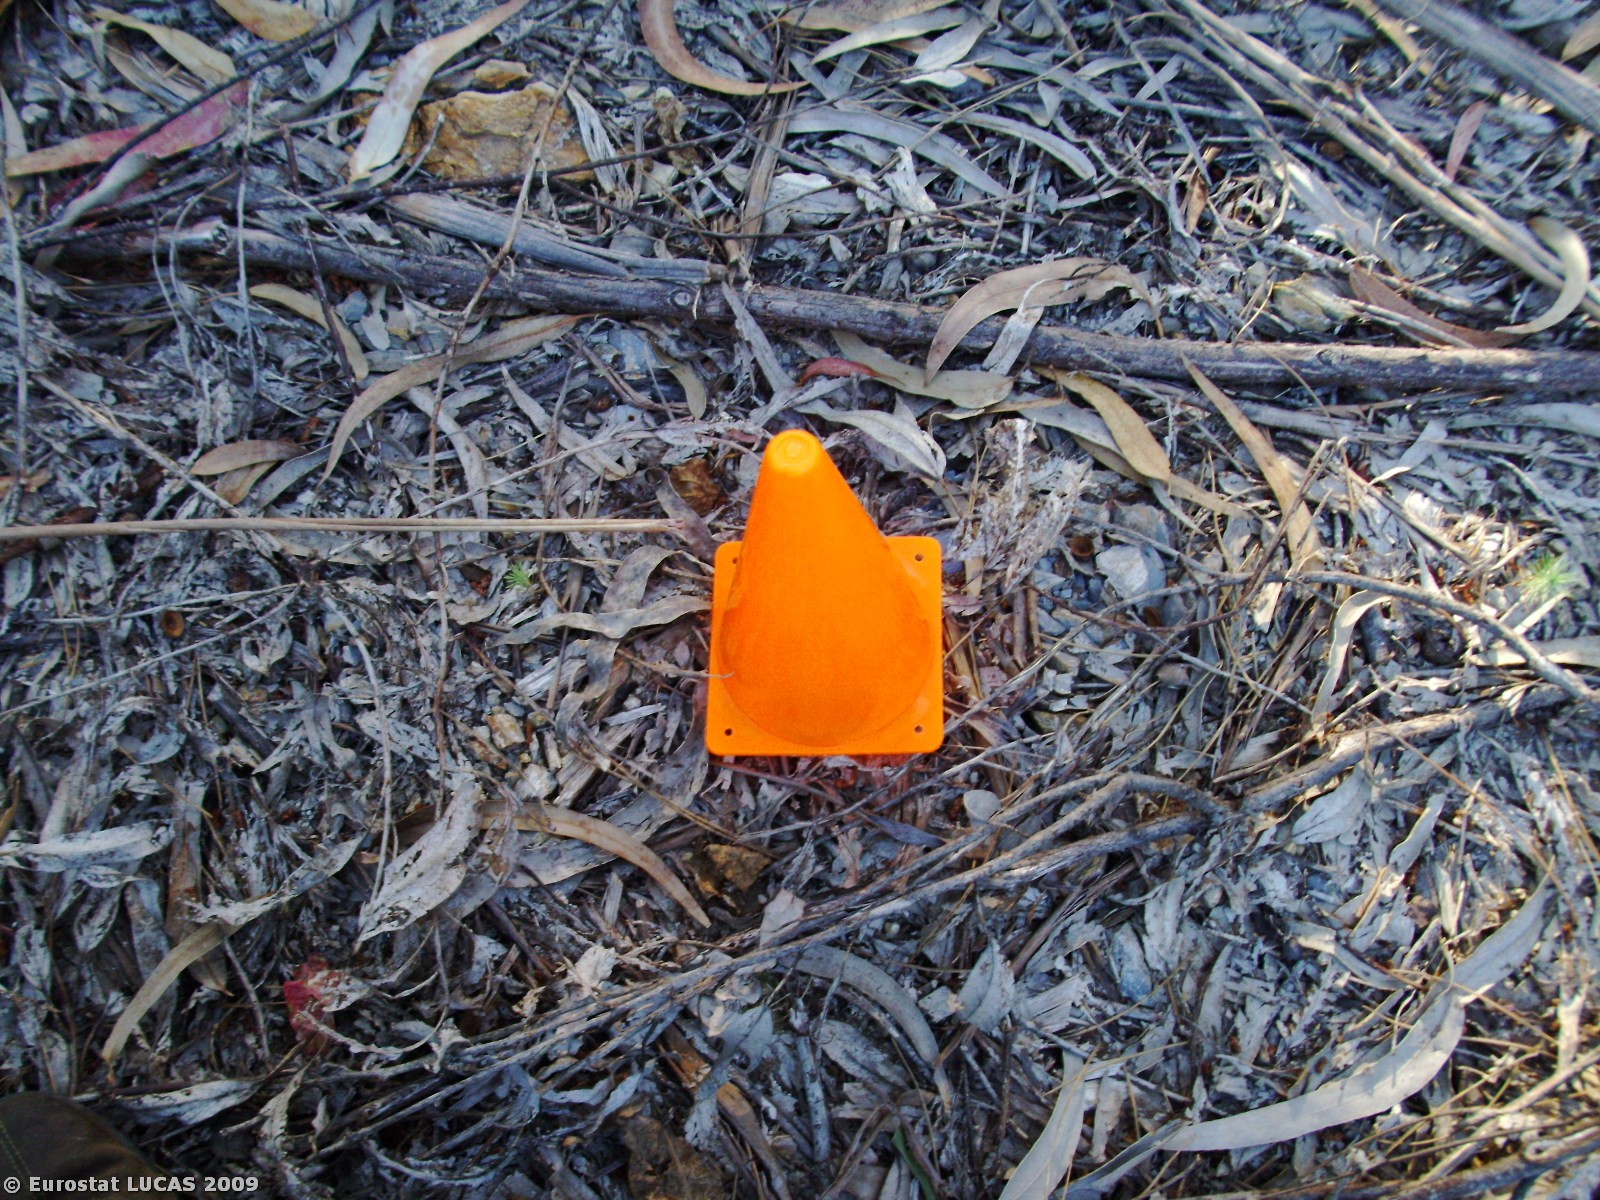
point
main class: Woodland
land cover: Broadleaved woodland
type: plantations and self-sown exotic forest
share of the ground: > 75 %
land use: Forestry
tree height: > 5 m
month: May
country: PT
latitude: 40.6183
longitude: -8.3999
